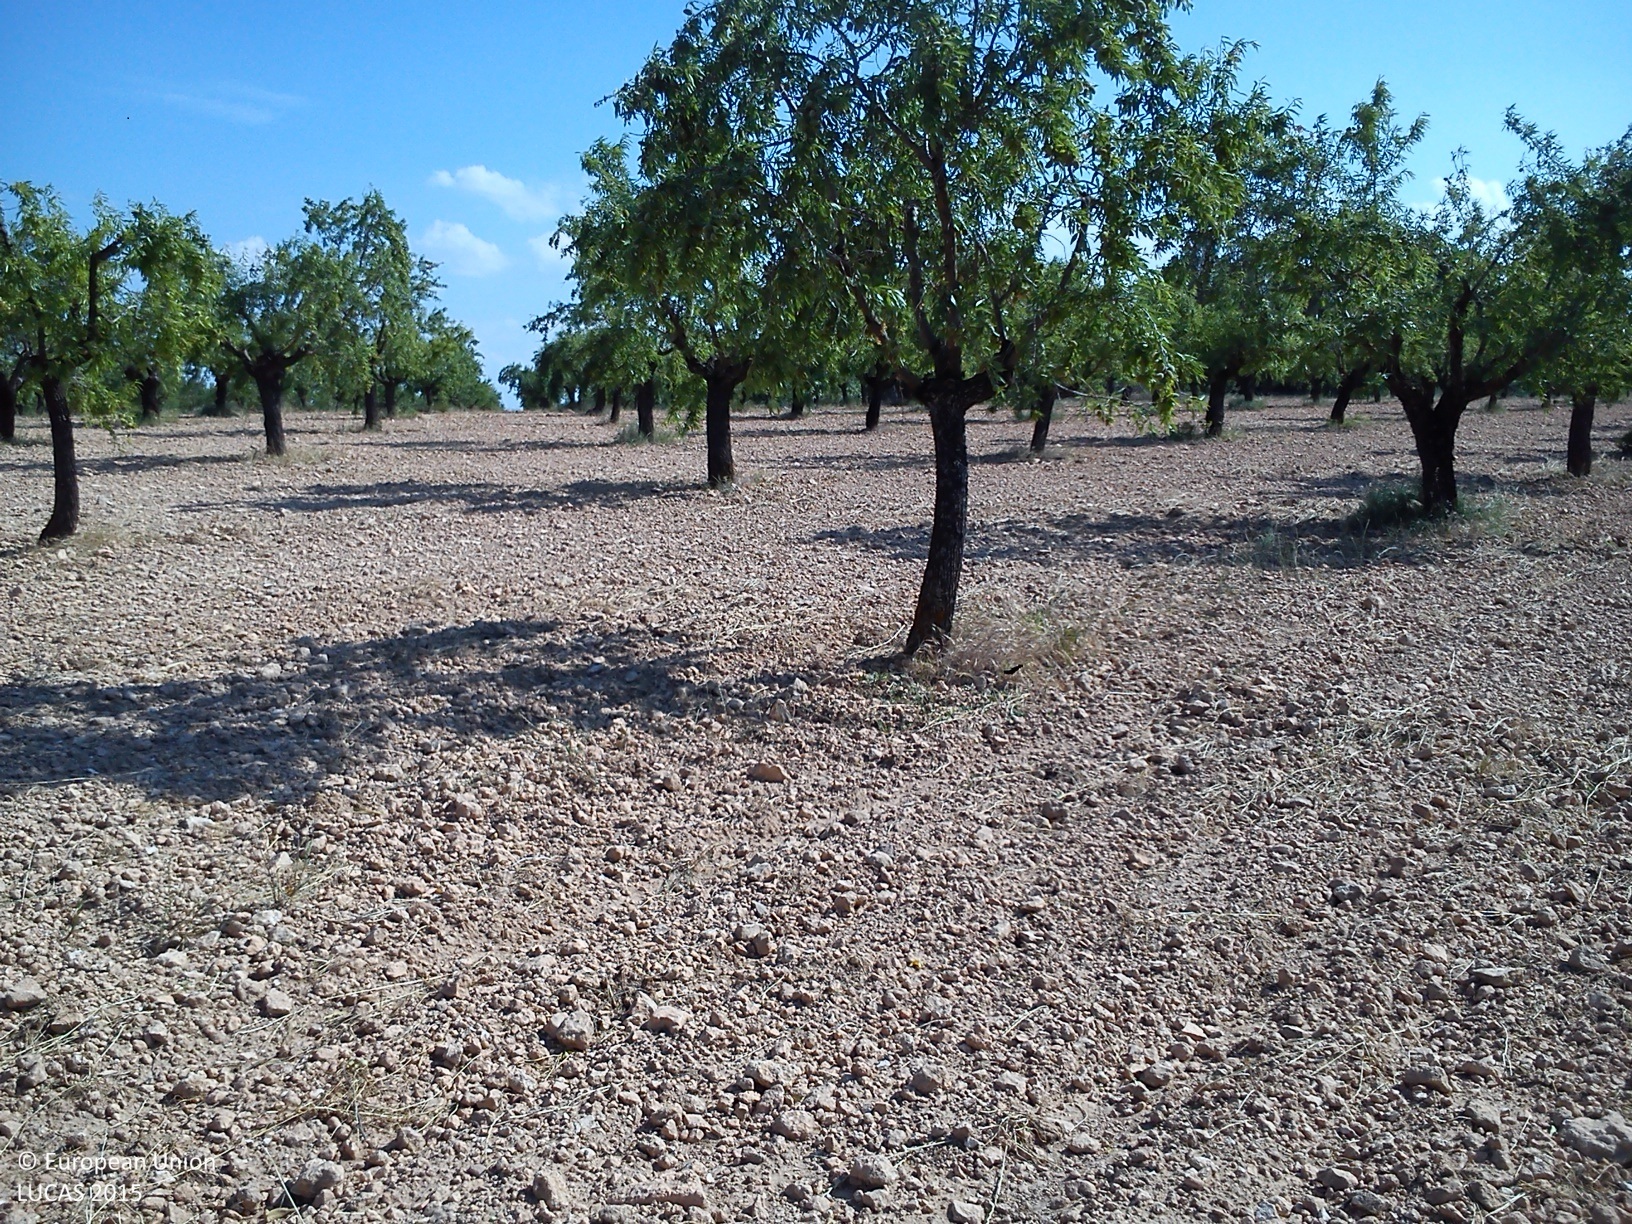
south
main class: Cropland
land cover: Nuts trees
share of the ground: 10 - 25 %
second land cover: Other bare soil
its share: > 75 %
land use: Agriculture (excluding fallow land and kitchen gardens)
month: June
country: ES
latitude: 39.3251
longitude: -1.1006
